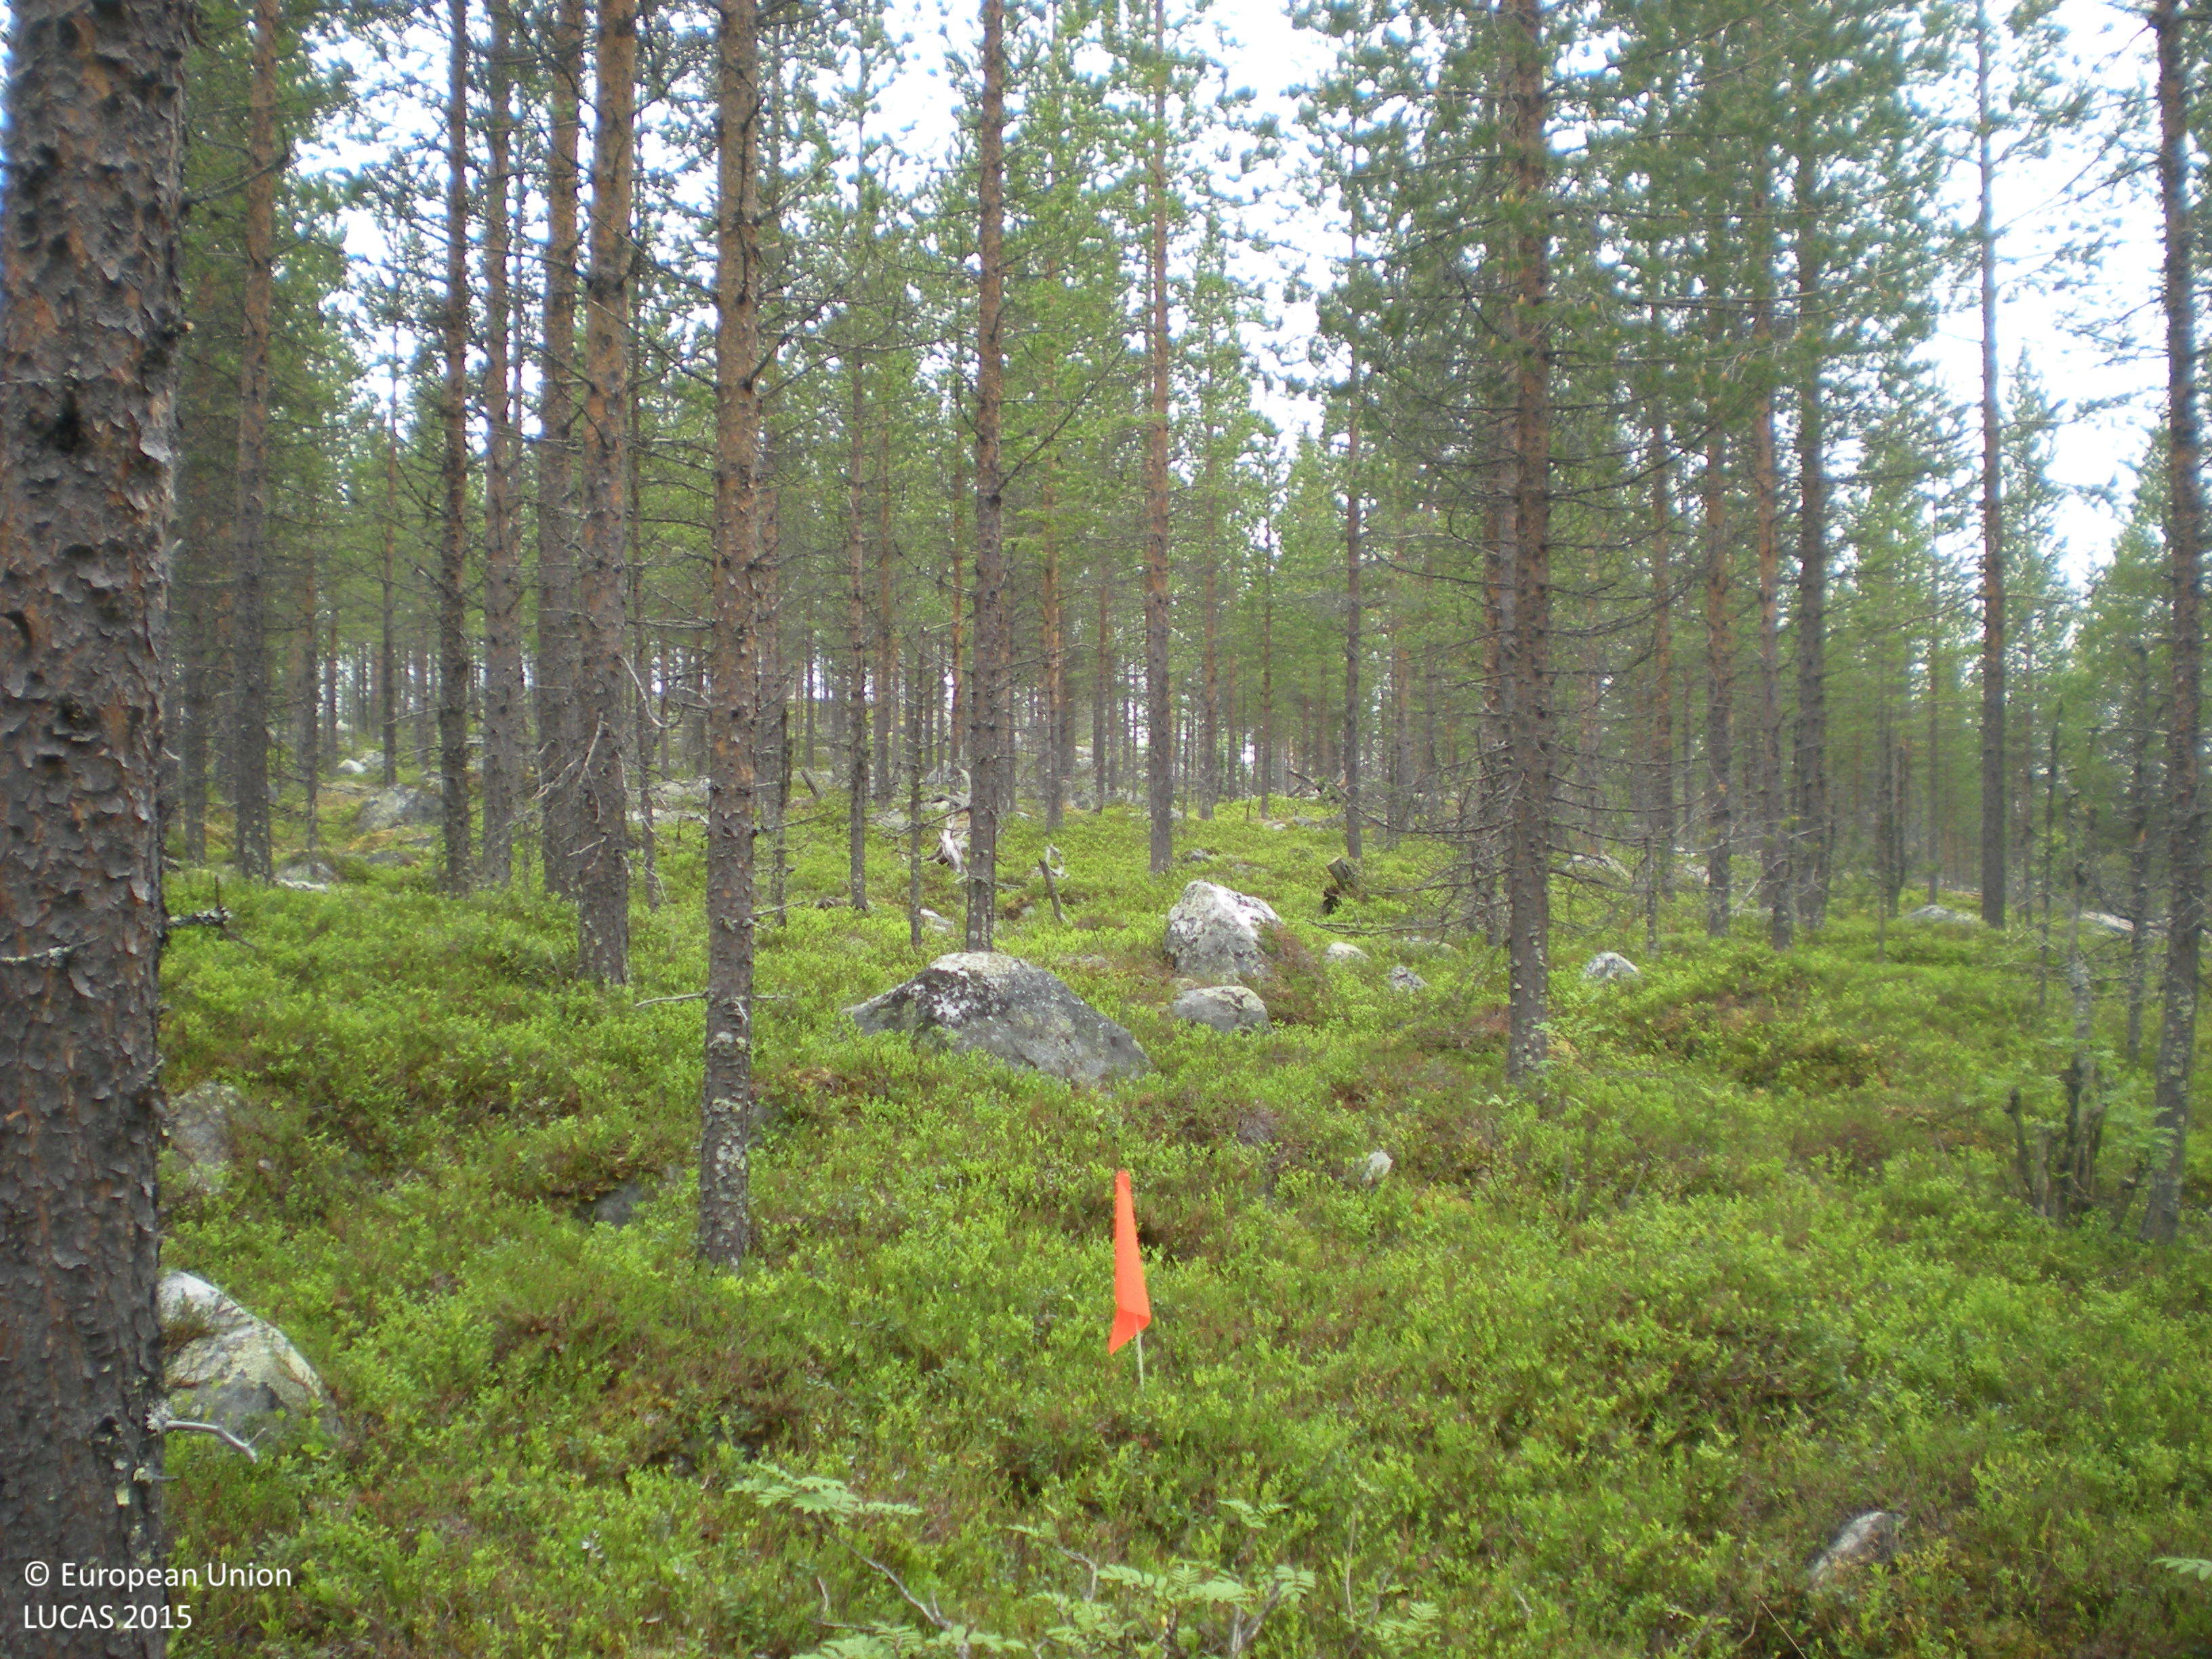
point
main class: Woodland
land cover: Pine dominated coniferous woodland
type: boreal forest
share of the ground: 50 - 75 %
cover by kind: coniferous forest trees 55 %, shrubs 30 %, consolidated bare surface 10 %, lichens and mosses 5 %
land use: Forestry
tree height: > 5 m
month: July
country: SE
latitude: 65.5109
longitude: 17.0733
